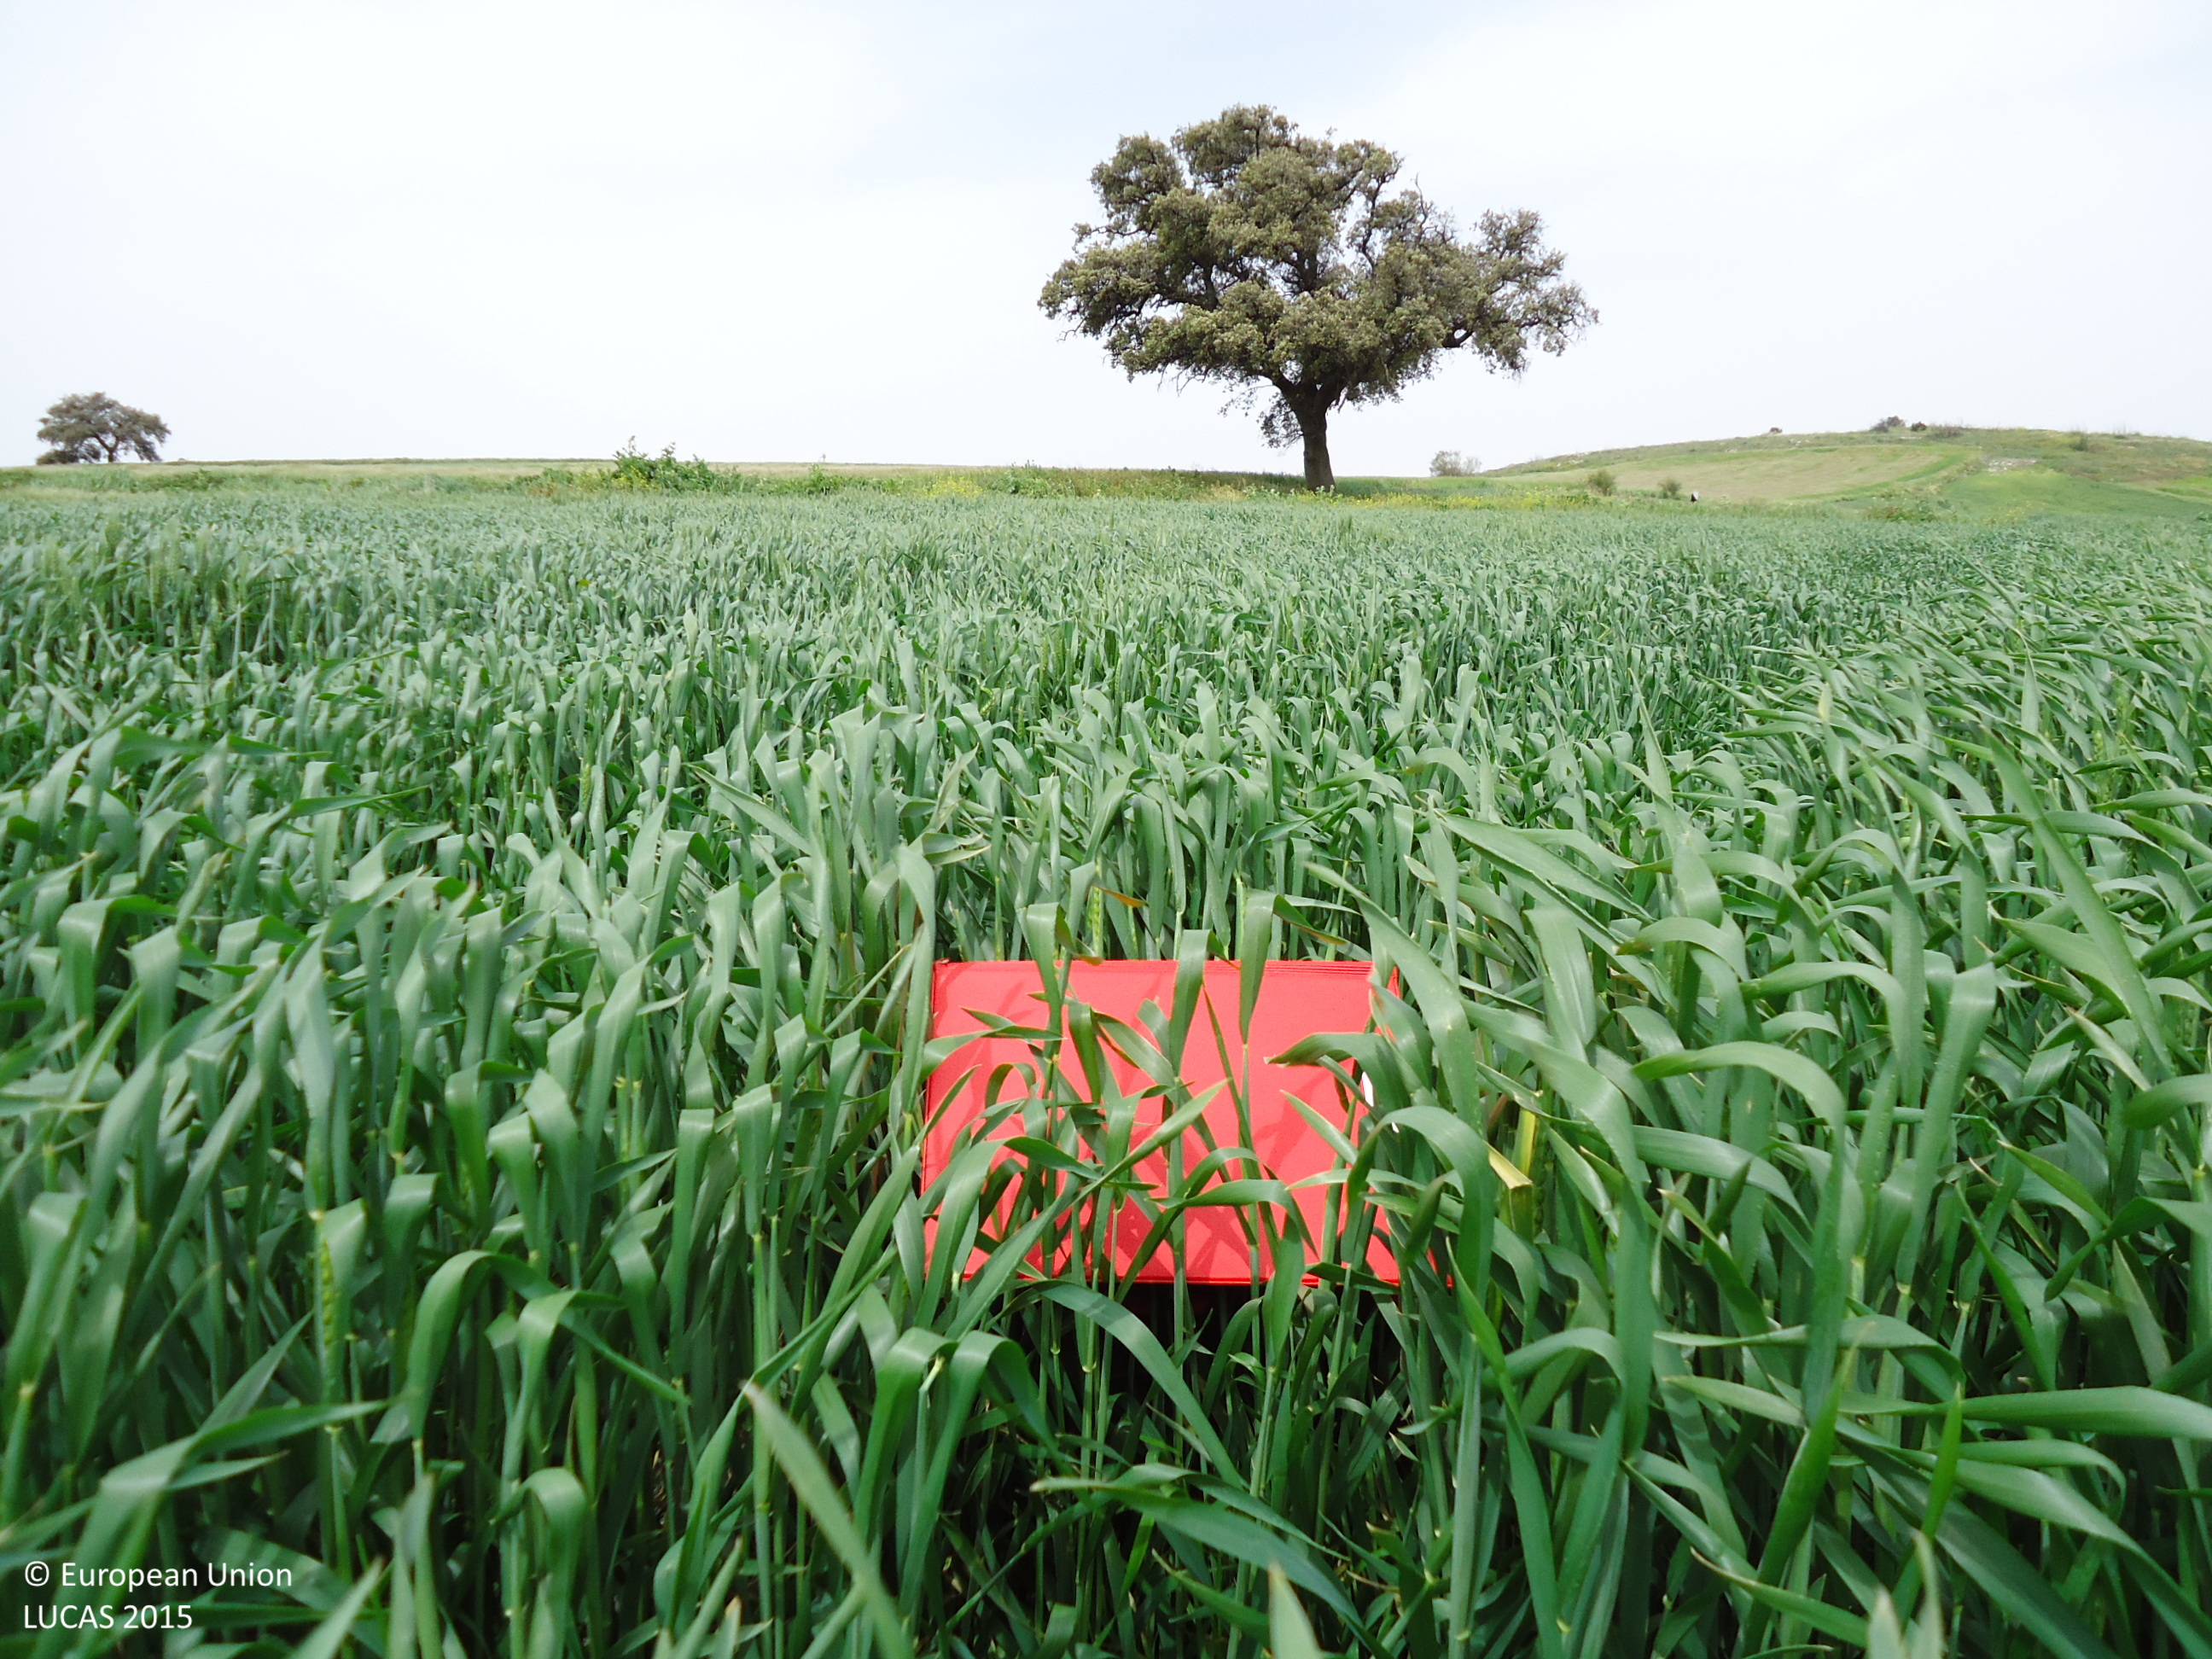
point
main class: Cropland
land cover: Barley
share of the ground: > 75 %
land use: Agriculture (excluding fallow land and kitchen gardens)
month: April
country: ES
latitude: 37.0418
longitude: -5.0352
